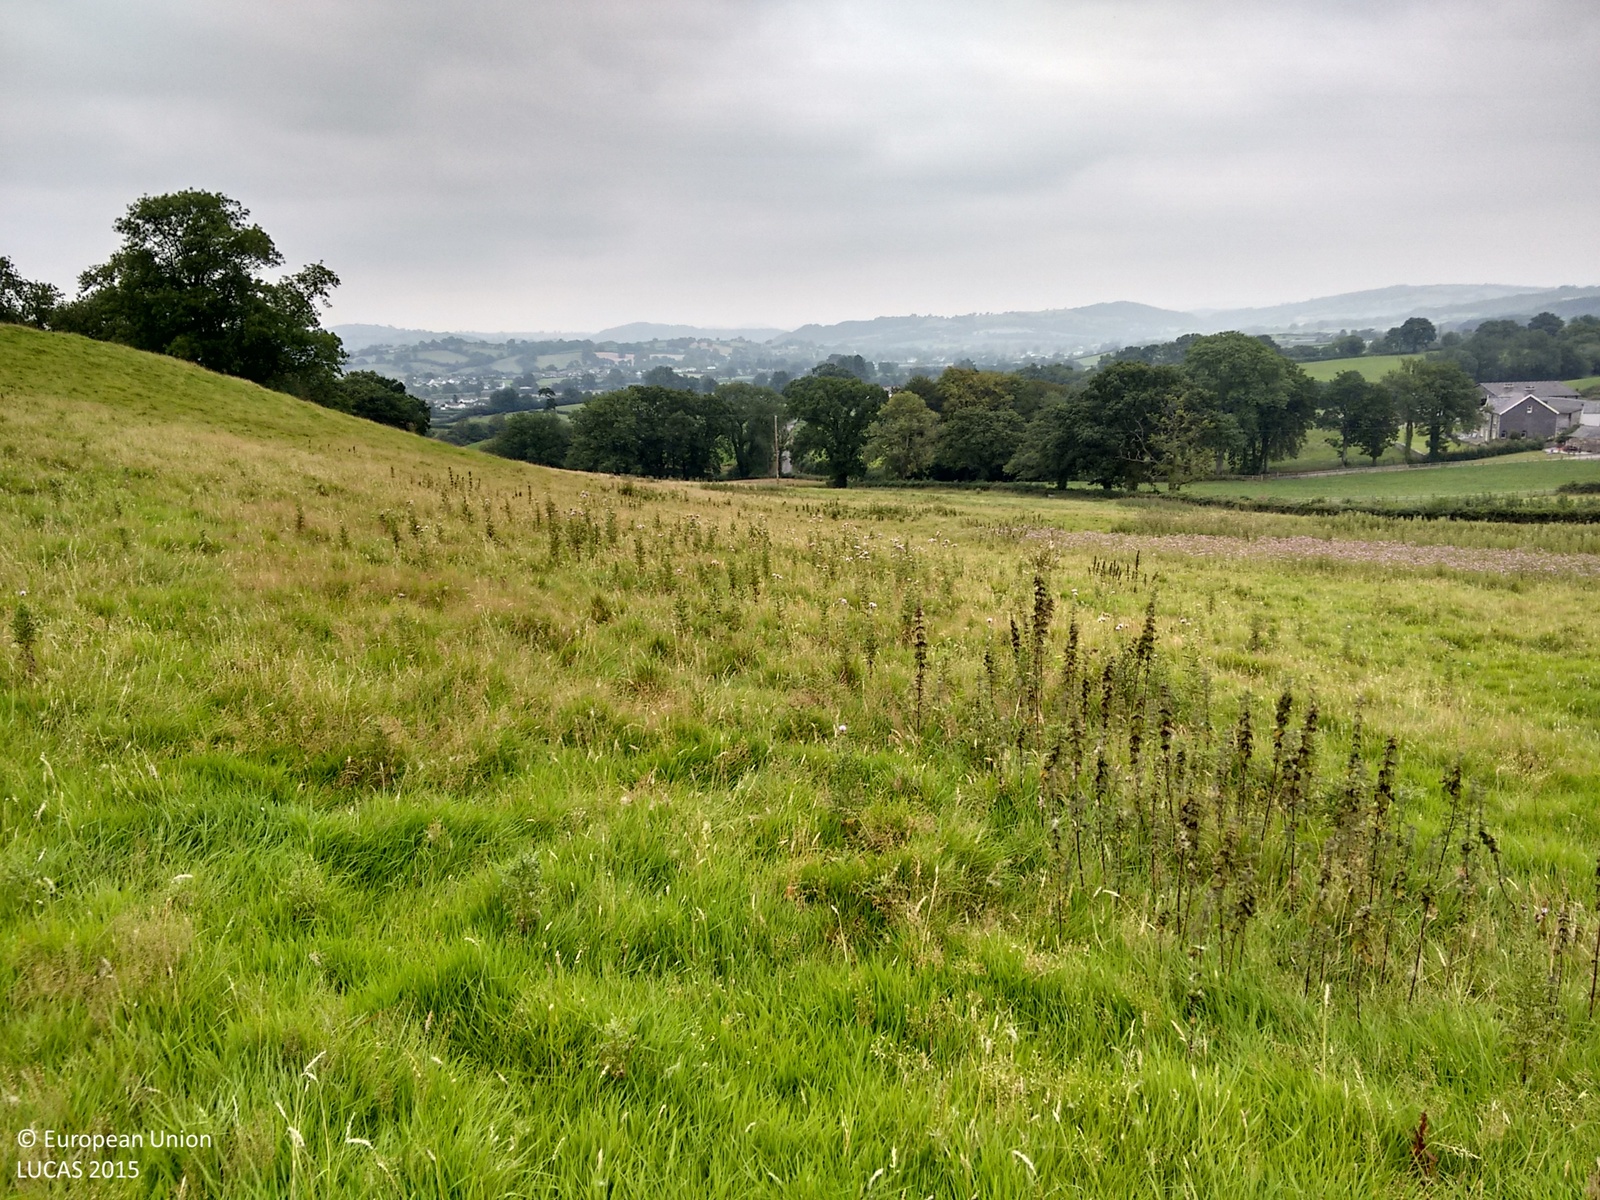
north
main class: Grassland
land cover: Grassland without tree/shrub cover
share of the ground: > 75 %
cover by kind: herbaceous plants 100 %
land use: Agriculture (excluding fallow land and kitchen gardens)
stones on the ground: < 10 %
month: August
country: GB
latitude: 51.9205
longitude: -3.8908
